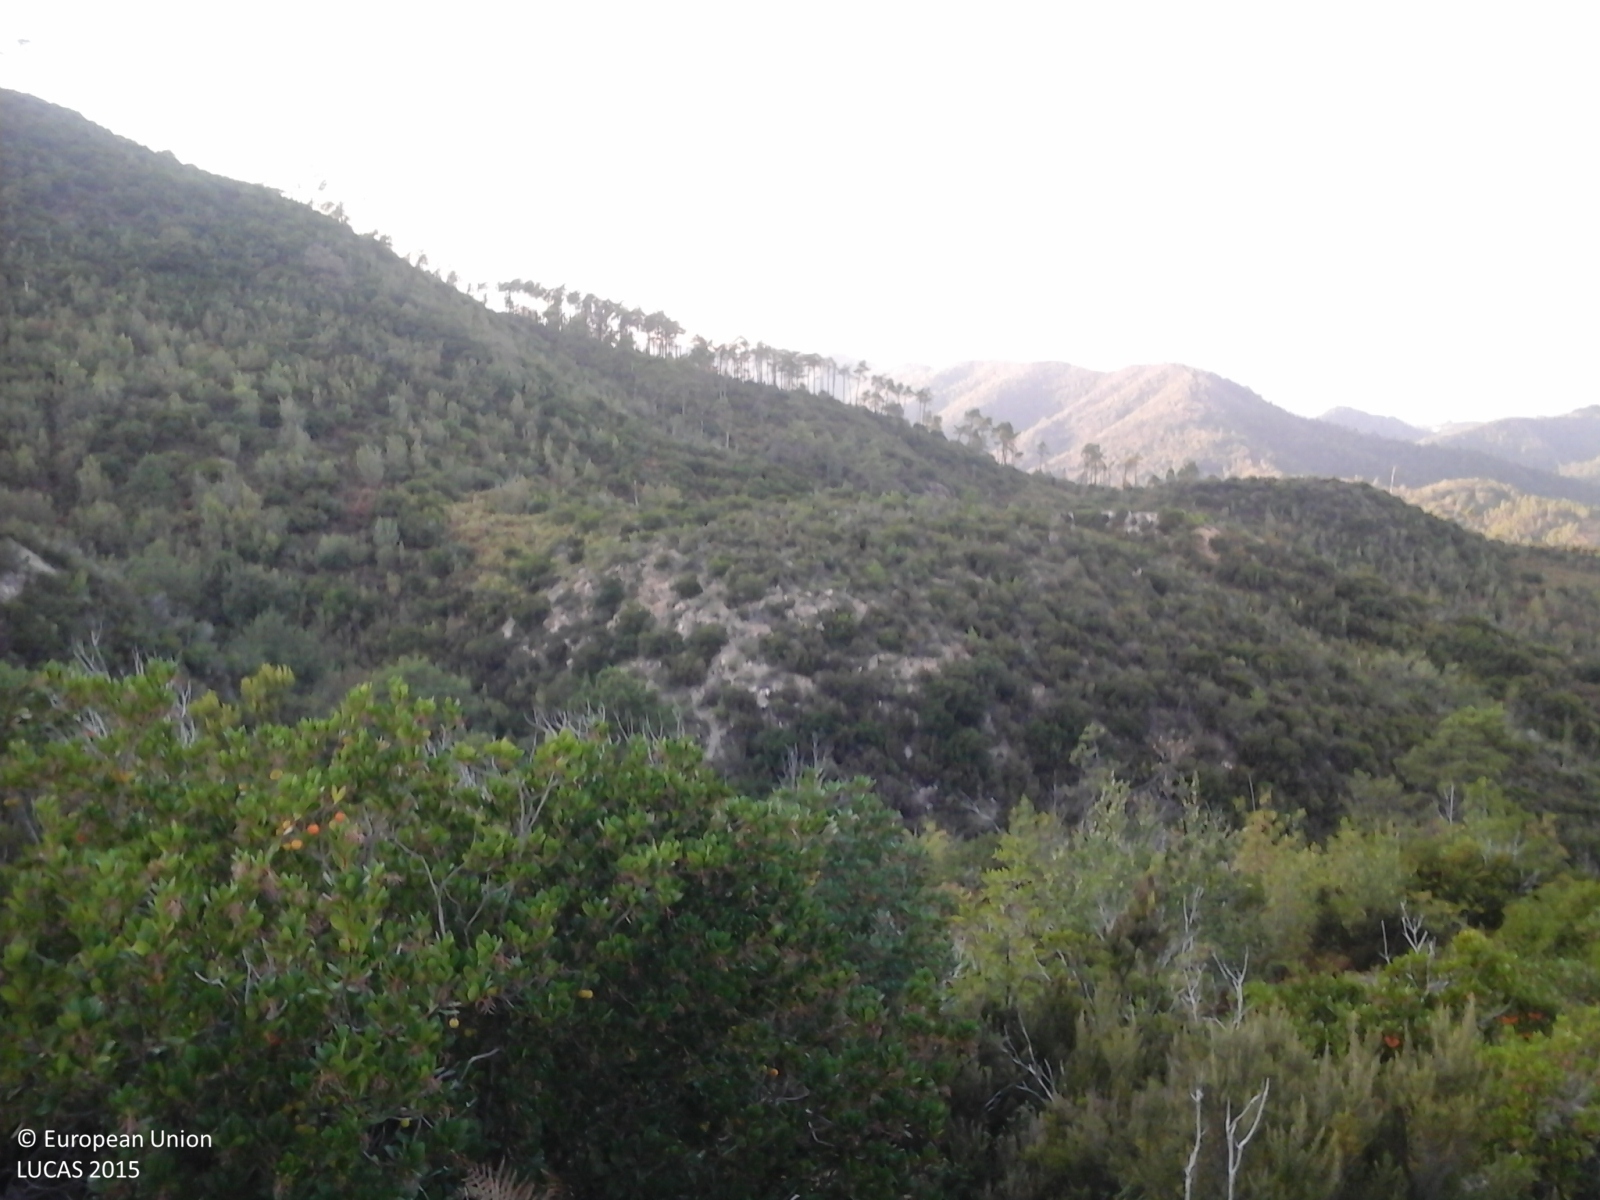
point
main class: Shrubland
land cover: Shrubland without tree cover
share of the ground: > 75 %
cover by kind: shrubs 80 %, herbaceous plants 10 %, consolidated bare surface 10 %
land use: Semi-natural and natural areas not in use
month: September
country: IT
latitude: 44.2843
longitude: 8.4122
